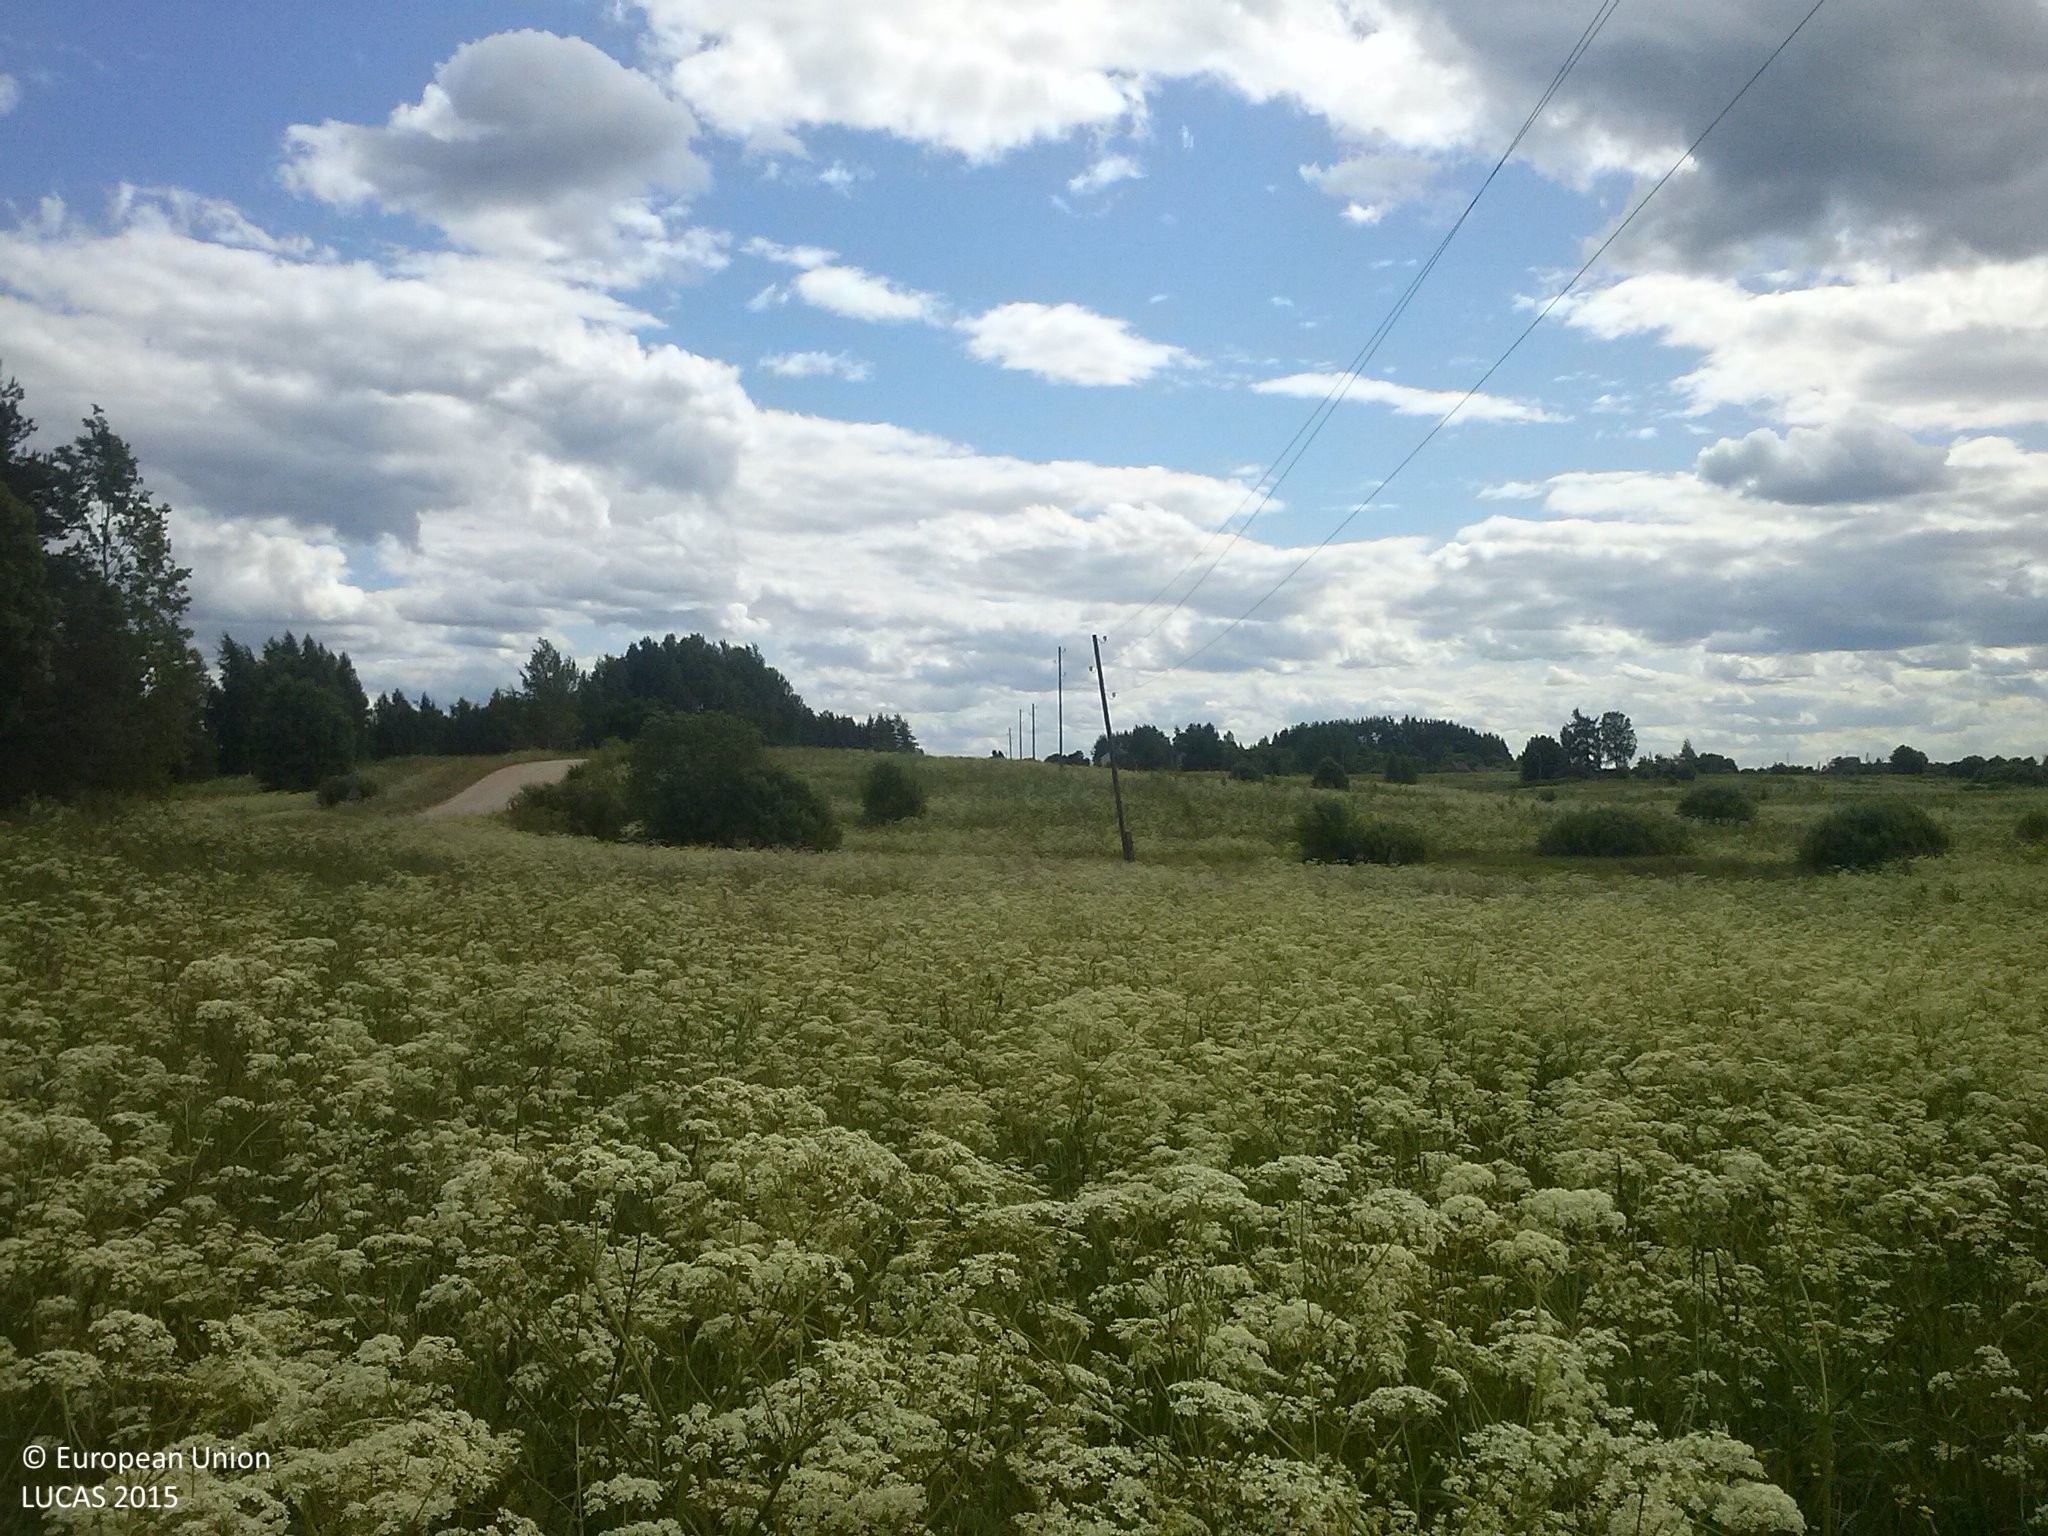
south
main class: Grassland
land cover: Spontaneously vegetated surfaces
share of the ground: > 75 %
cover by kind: herbaceous plants 100 %
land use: Semi-natural and natural areas not in use
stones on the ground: < 10 %
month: June
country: LV
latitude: 56.4224
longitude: 27.6786
